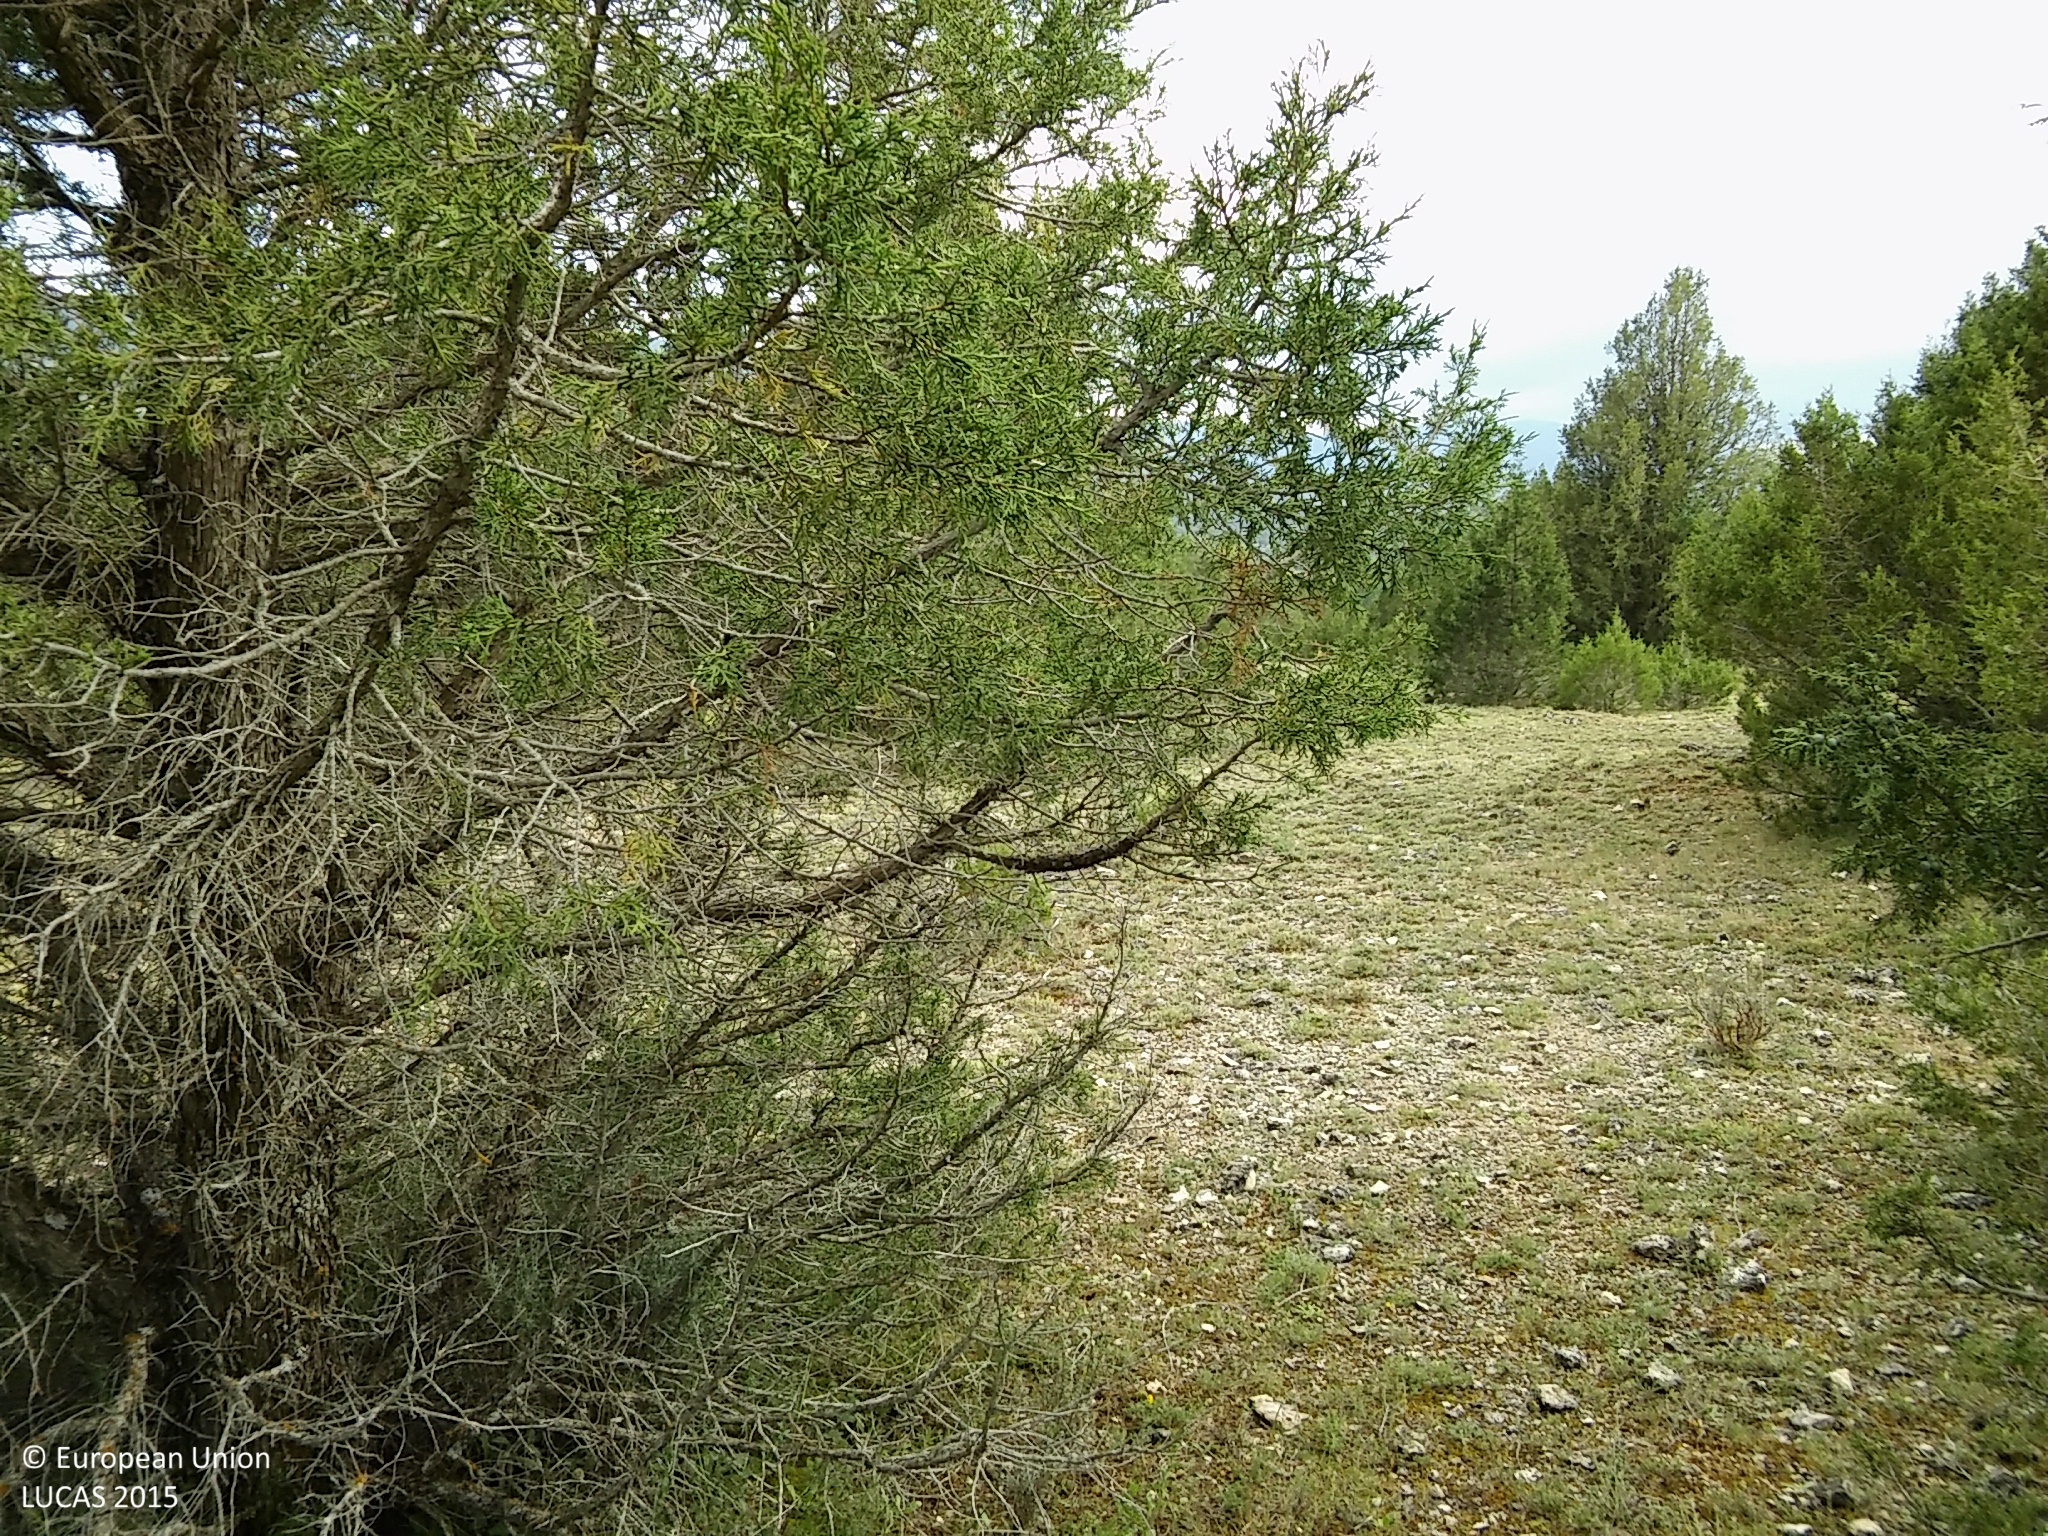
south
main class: Woodland
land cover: Other coniferous woodland
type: coniferous forest of the mediterranean region
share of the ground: 25 - 50 %
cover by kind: coniferous forest trees 30 %, shrubs 20 %, lichens and mosses 20 %, unconsolidated bare surface 20 %, herbaceous plants 10 %
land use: Forestry
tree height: > 5 m
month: June
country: ES
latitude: 41.1765
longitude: -3.6474
